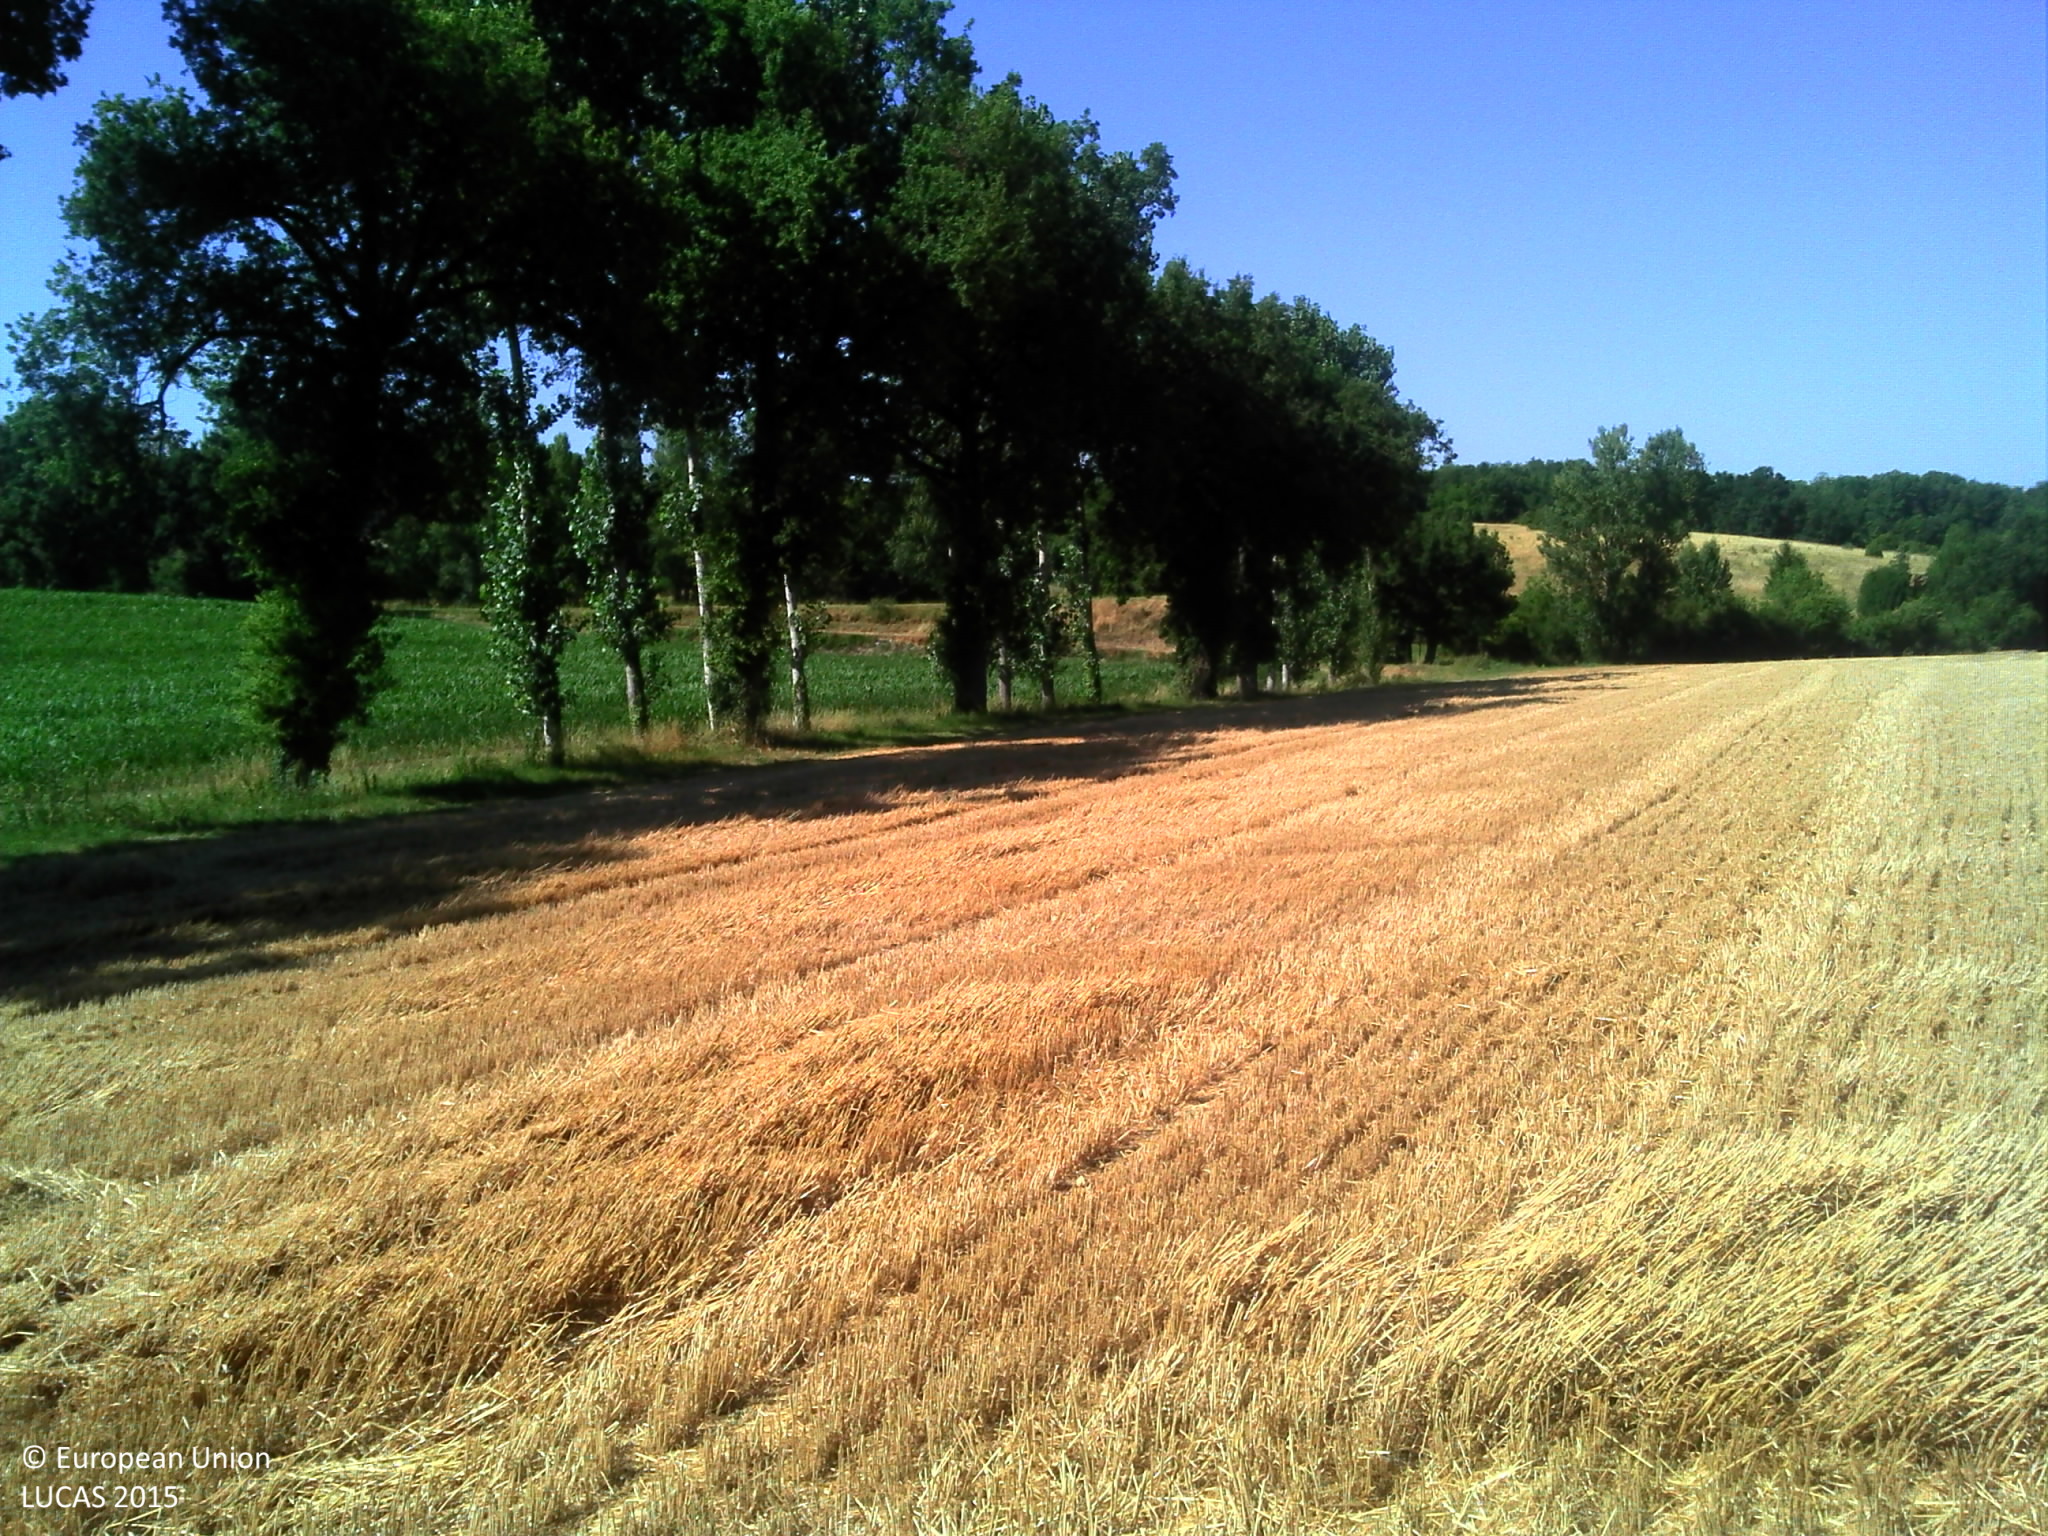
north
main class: Cropland
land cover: Common wheat
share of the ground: > 75 %
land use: Agriculture (excluding fallow land and kitchen gardens)
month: July
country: FR
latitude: 43.9470
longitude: 0.6640
